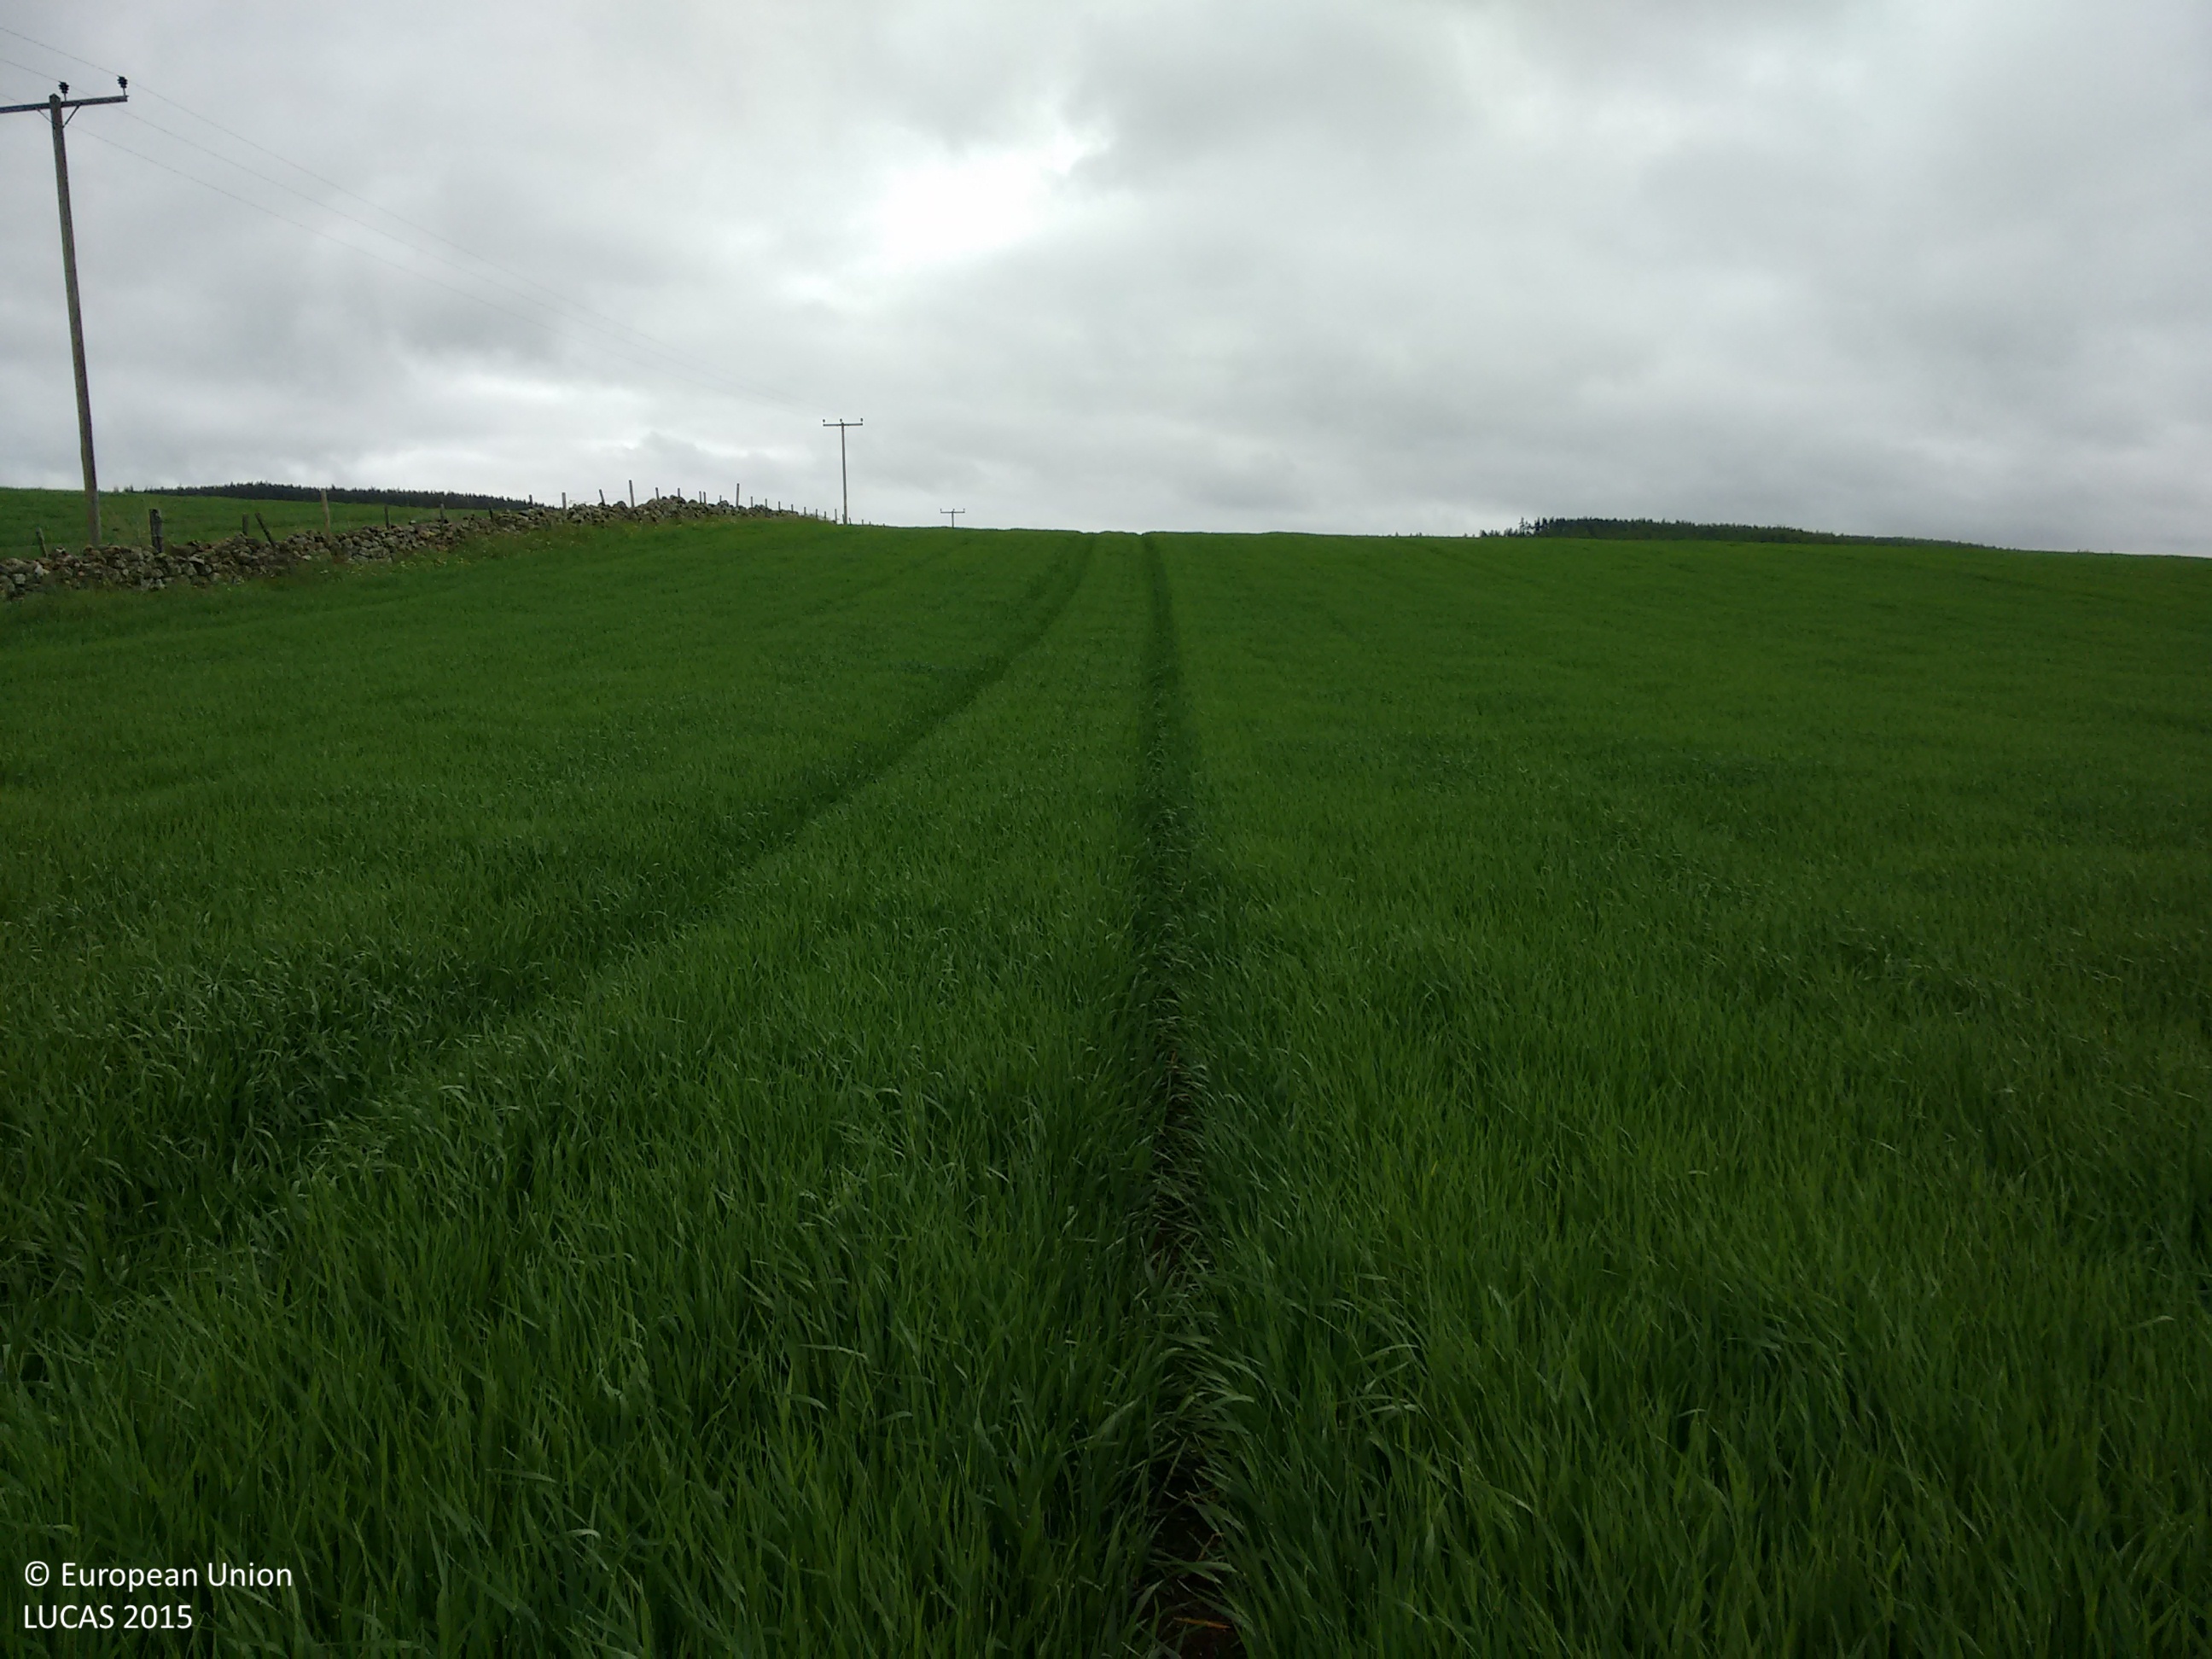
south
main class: Cropland
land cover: Barley
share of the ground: > 75 %
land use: Agriculture (excluding fallow land and kitchen gardens)
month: June
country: GB
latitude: 57.0628
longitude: -2.7400
